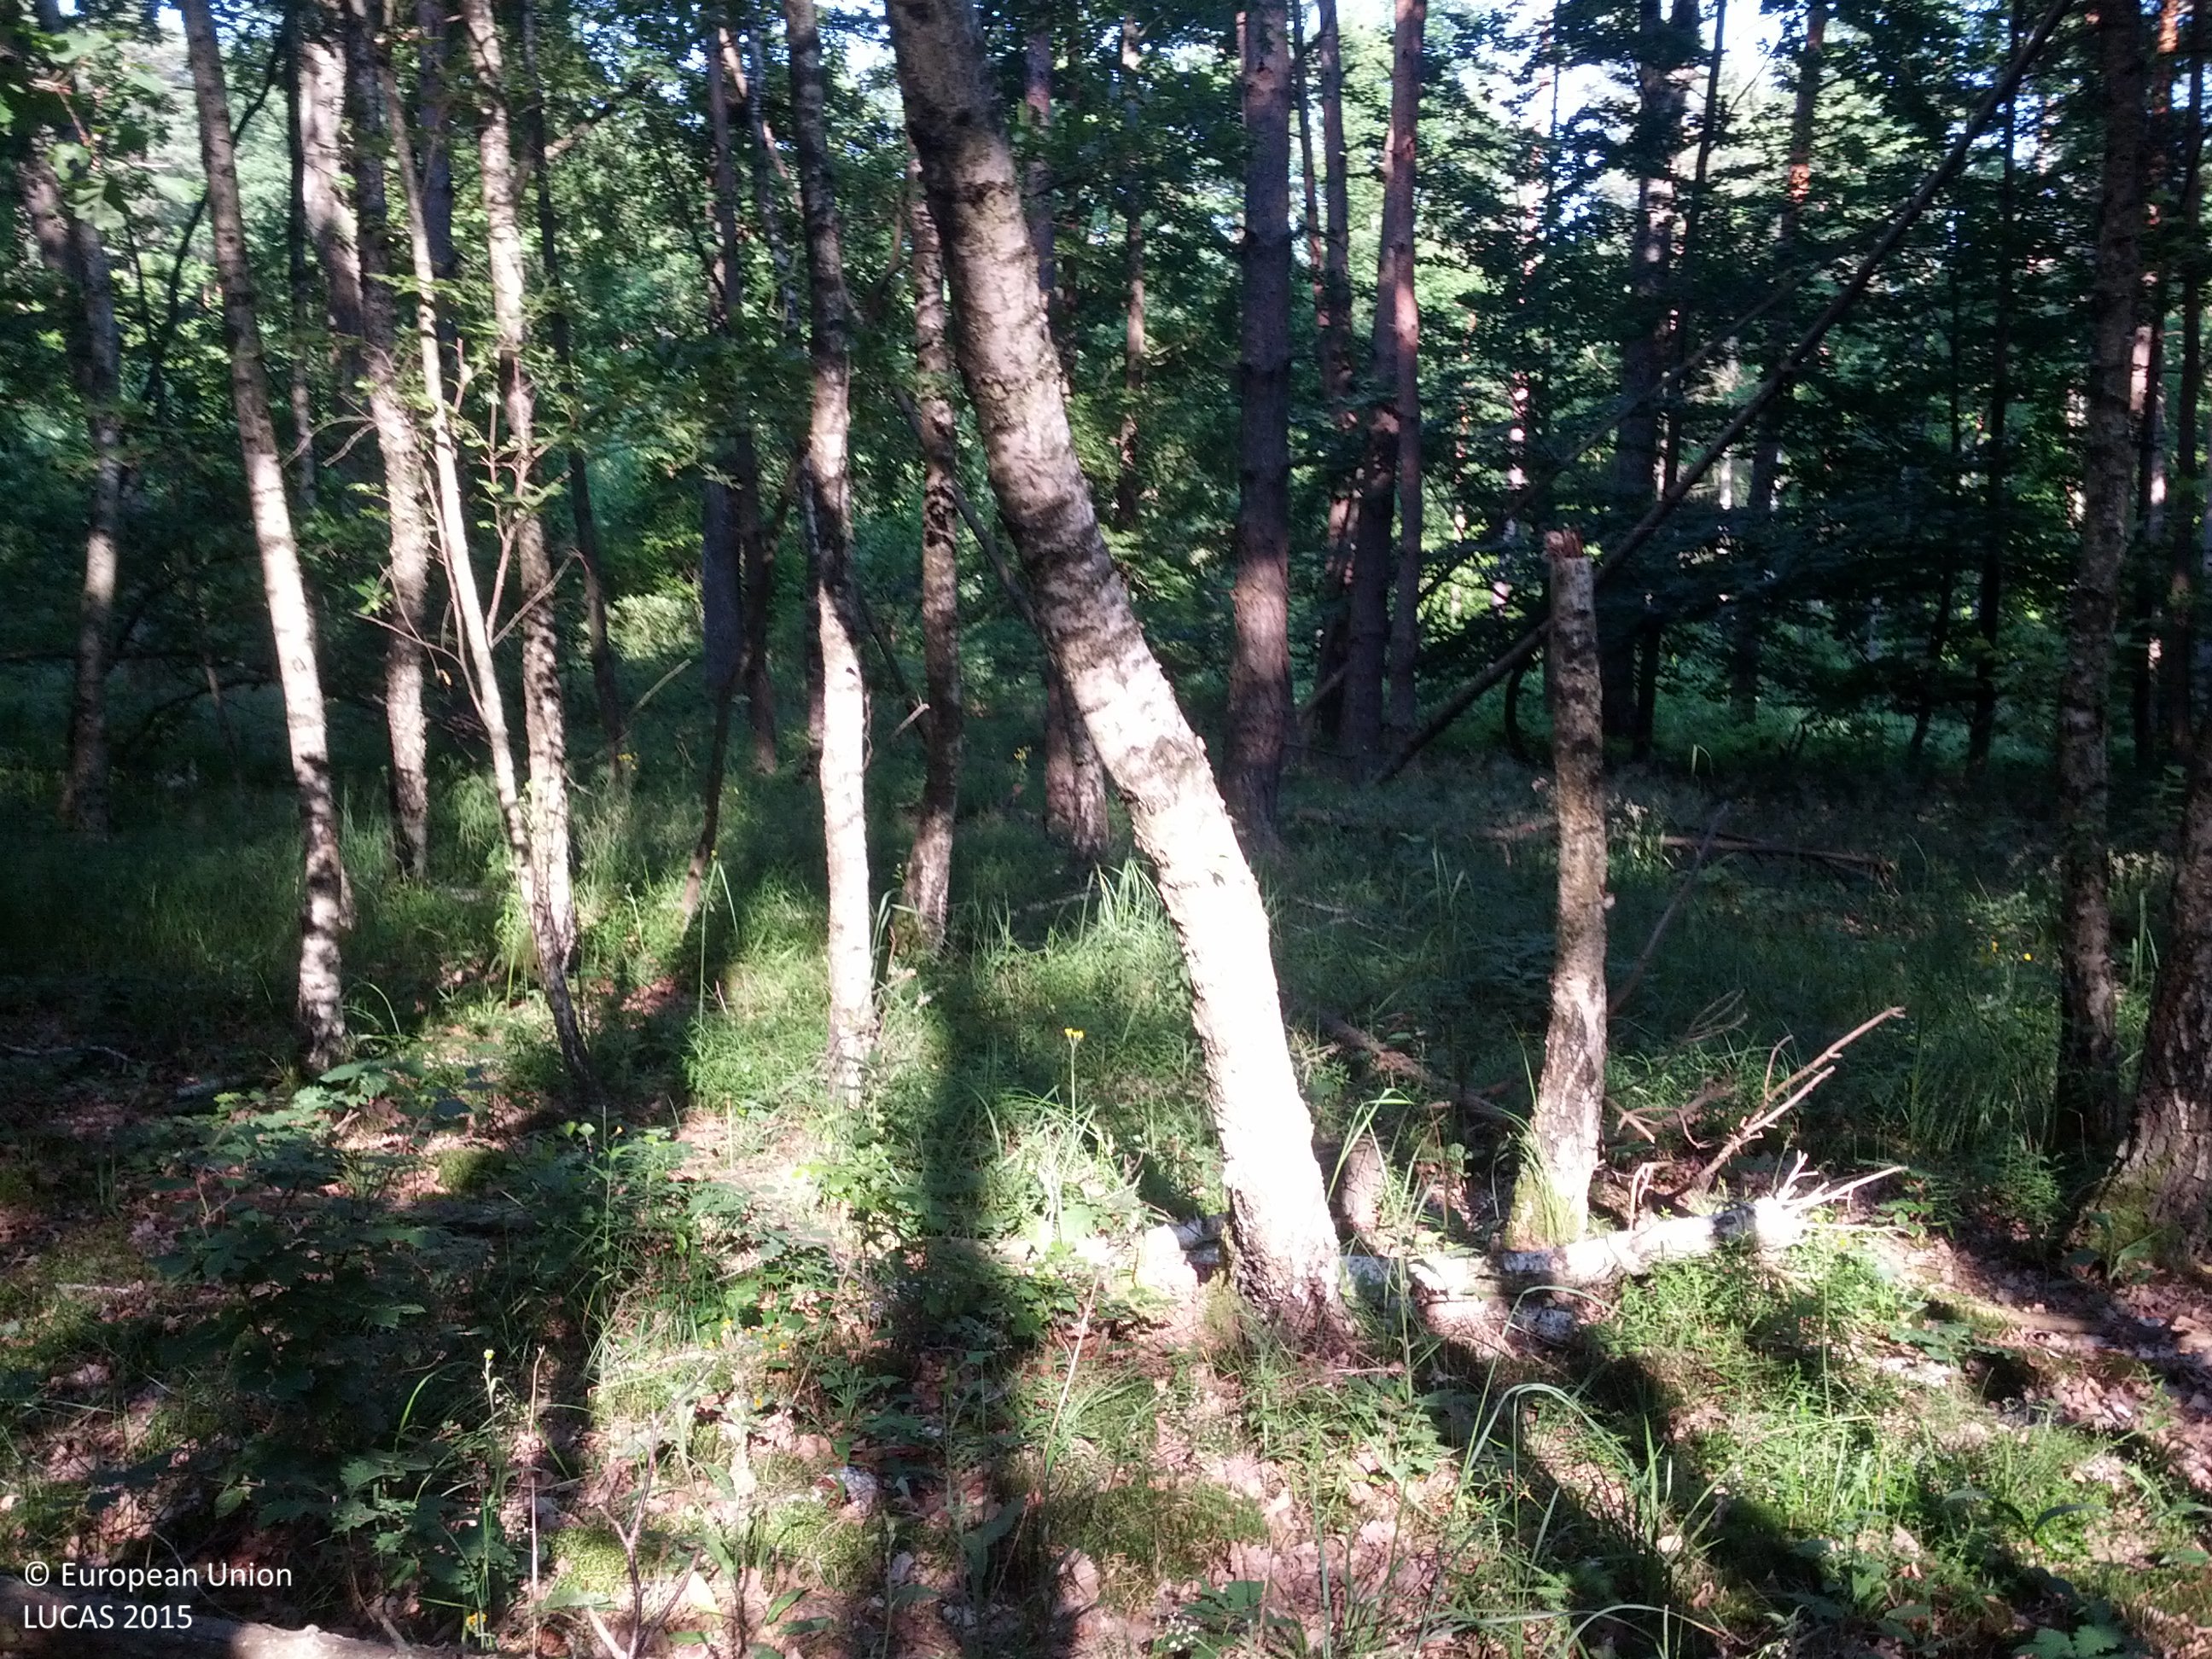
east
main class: Woodland
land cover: Pine dominated mixed woodland
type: hemiboreal forest and nemoral coniferous forest and mixed broadleaved-coniferous forest
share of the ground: 50 - 75 %
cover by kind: coniferous forest trees 50 %, broadleaved forest trees 30 %, herbaceous plants 20 %
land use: Forestry
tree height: > 5 m
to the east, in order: Pine dominated mixed woodland; Broadleaved woodland; Spruce dominated mixed woodland; Tracks; Pine dominated mixed woodland; Tracks; Pine dominated mixed woodland; Broadleaved woodland
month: June
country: AT
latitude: 47.0080
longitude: 16.4078
